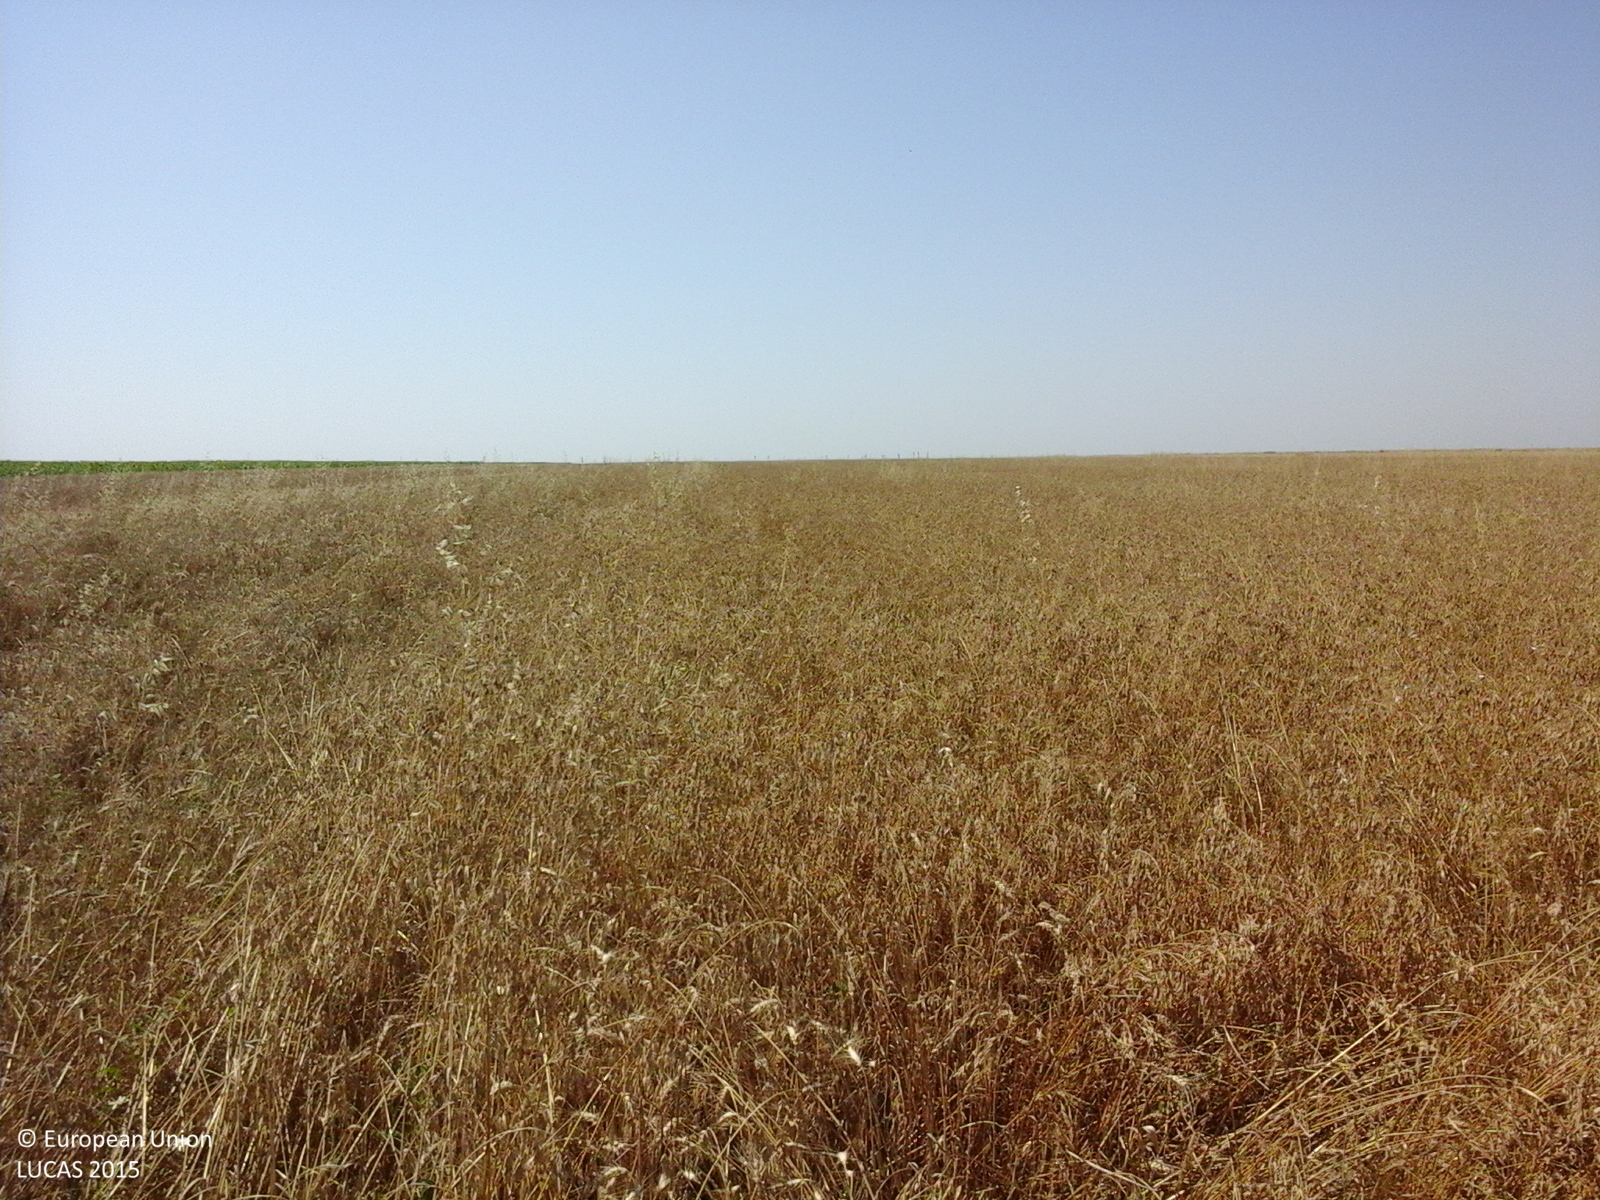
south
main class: Cropland
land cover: Common wheat
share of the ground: > 75 %
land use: Agriculture (excluding fallow land and kitchen gardens)
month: July
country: RO
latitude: 44.3705
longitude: 24.4888
